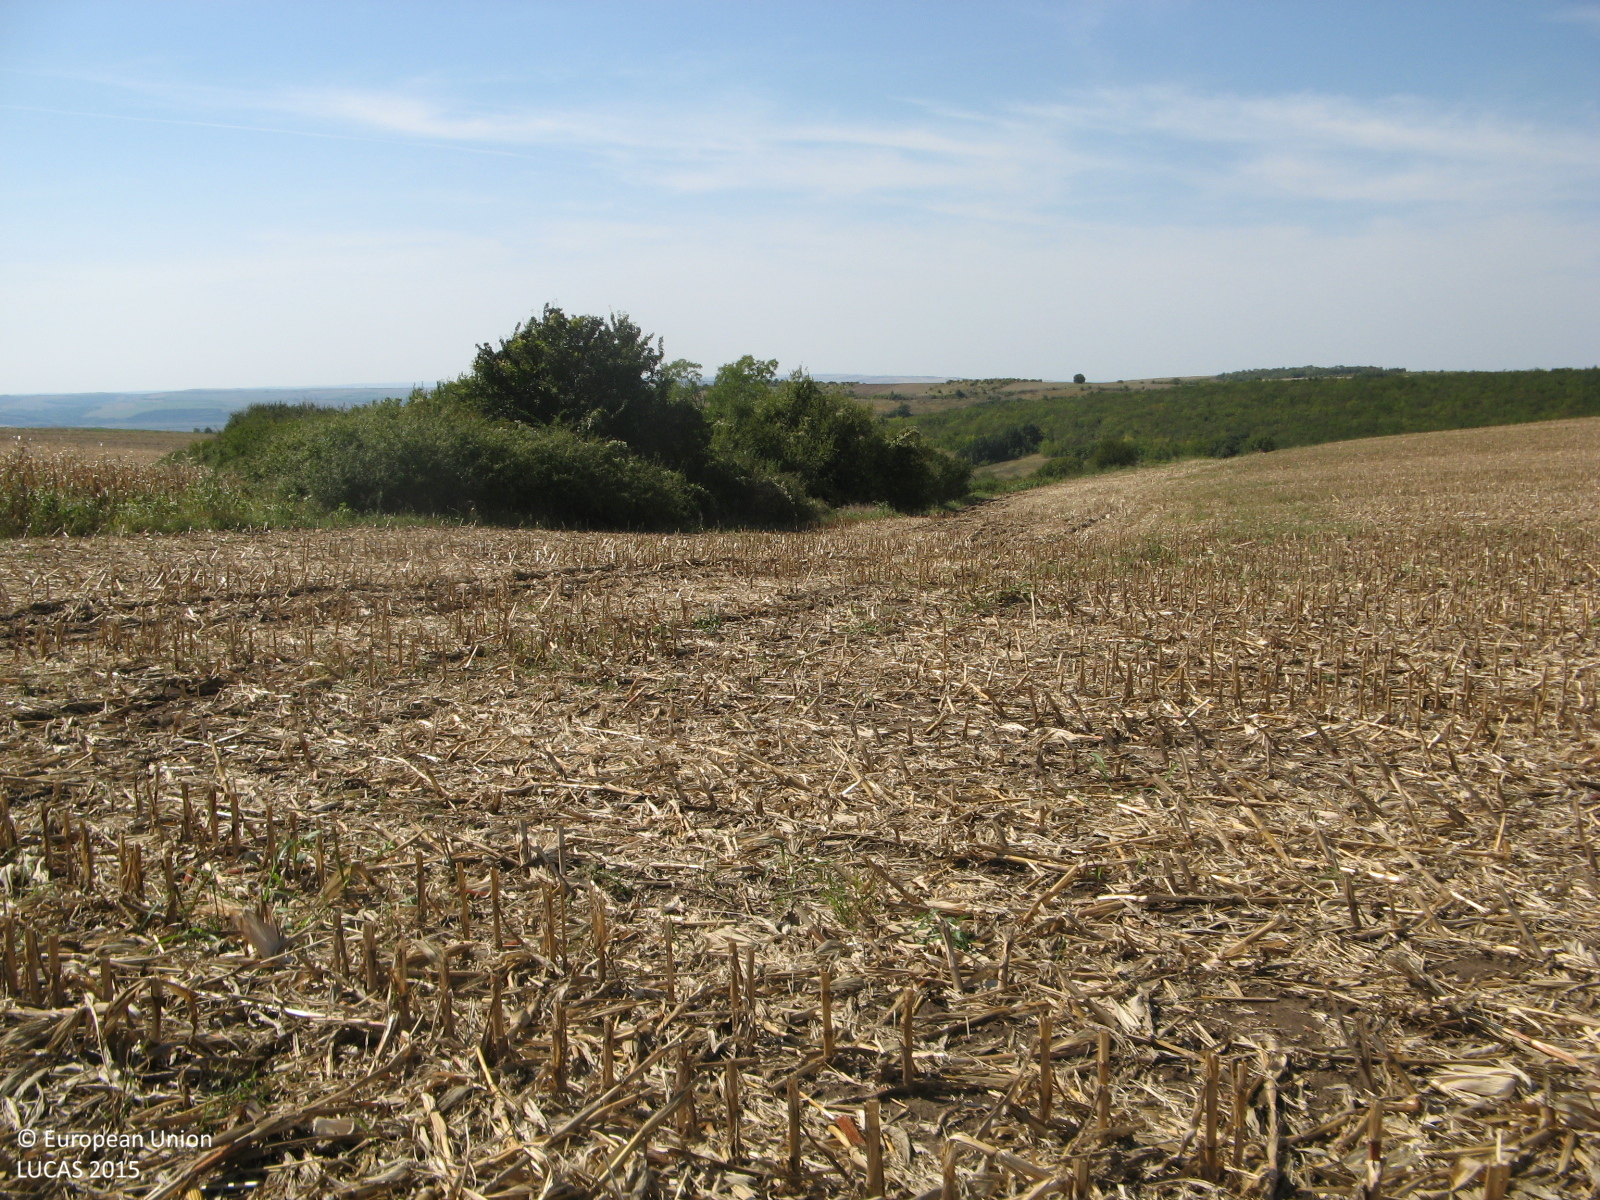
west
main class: Cropland
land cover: Maize
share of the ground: 10 - 25 %
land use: Agriculture (excluding fallow land and kitchen gardens)
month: September
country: BG
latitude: 43.5686
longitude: 25.6997
